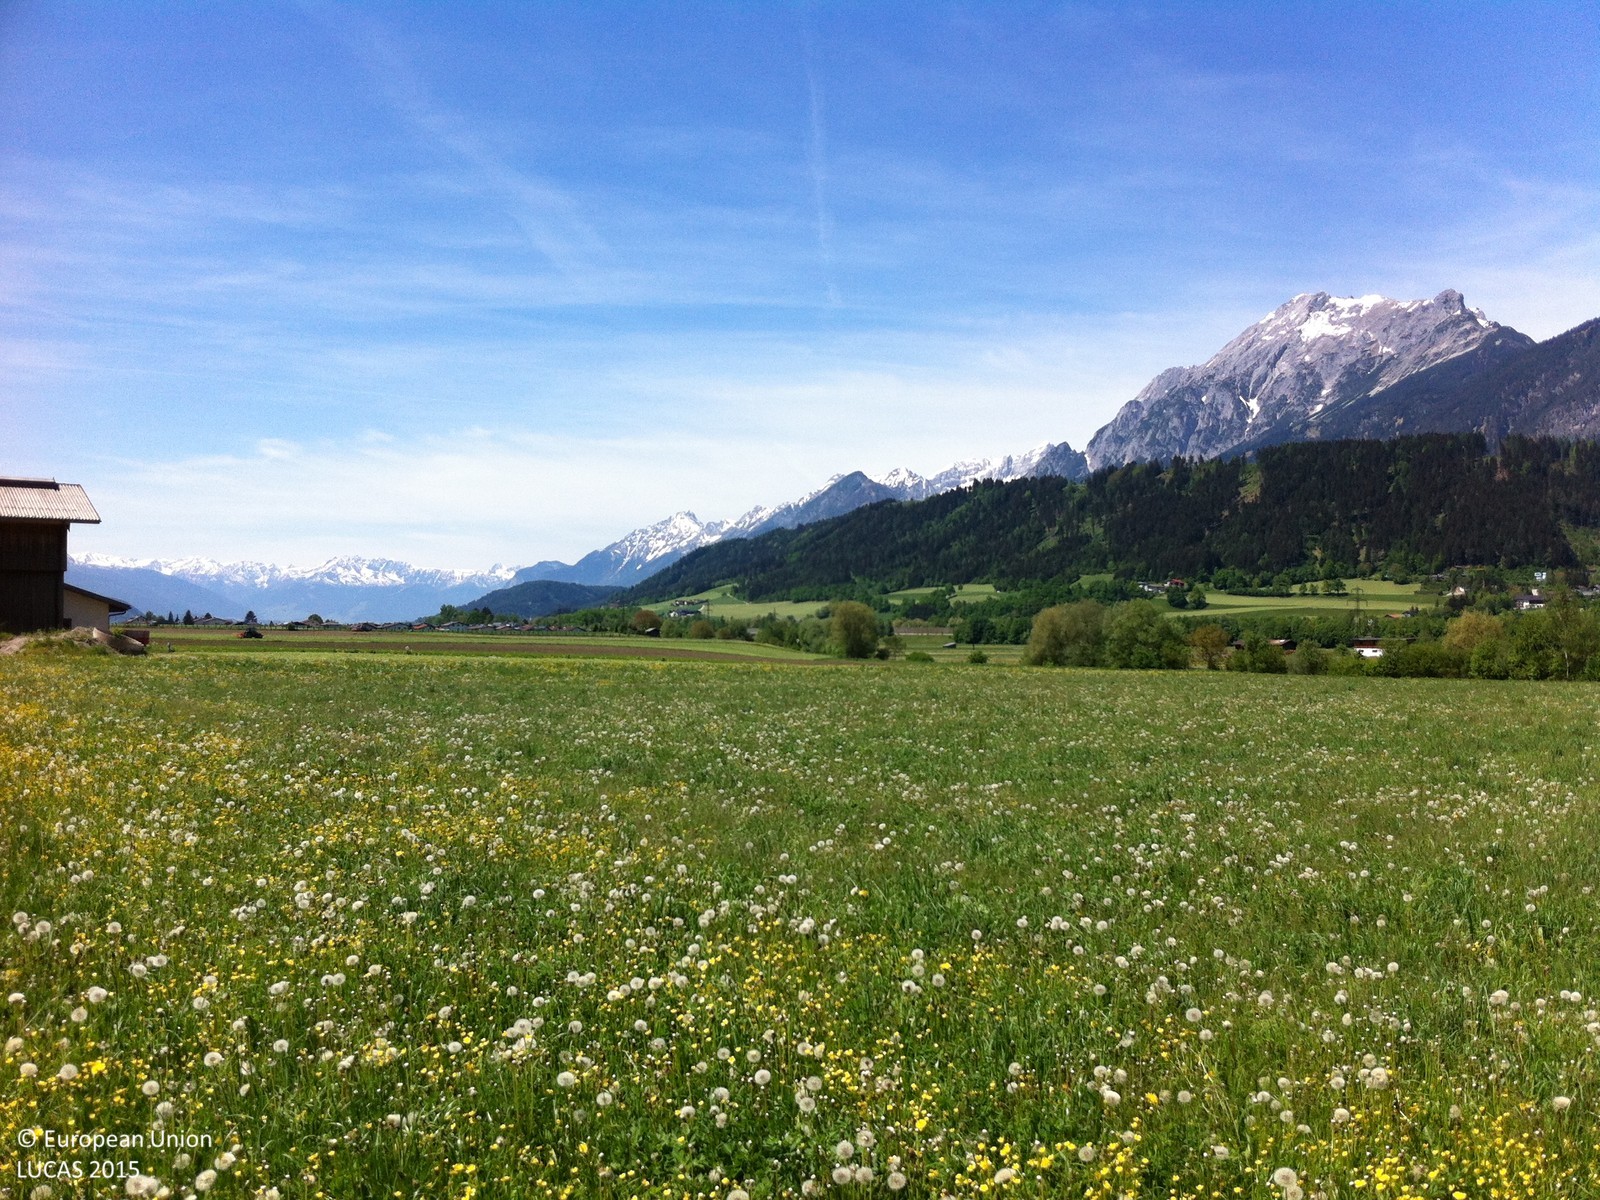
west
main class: Grassland
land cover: Grassland without tree/shrub cover
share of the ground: > 75 %
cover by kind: herbaceous plants 100 %
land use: Agriculture (excluding fallow land and kitchen gardens)
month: May
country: AT
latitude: 47.3111
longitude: 11.6521
